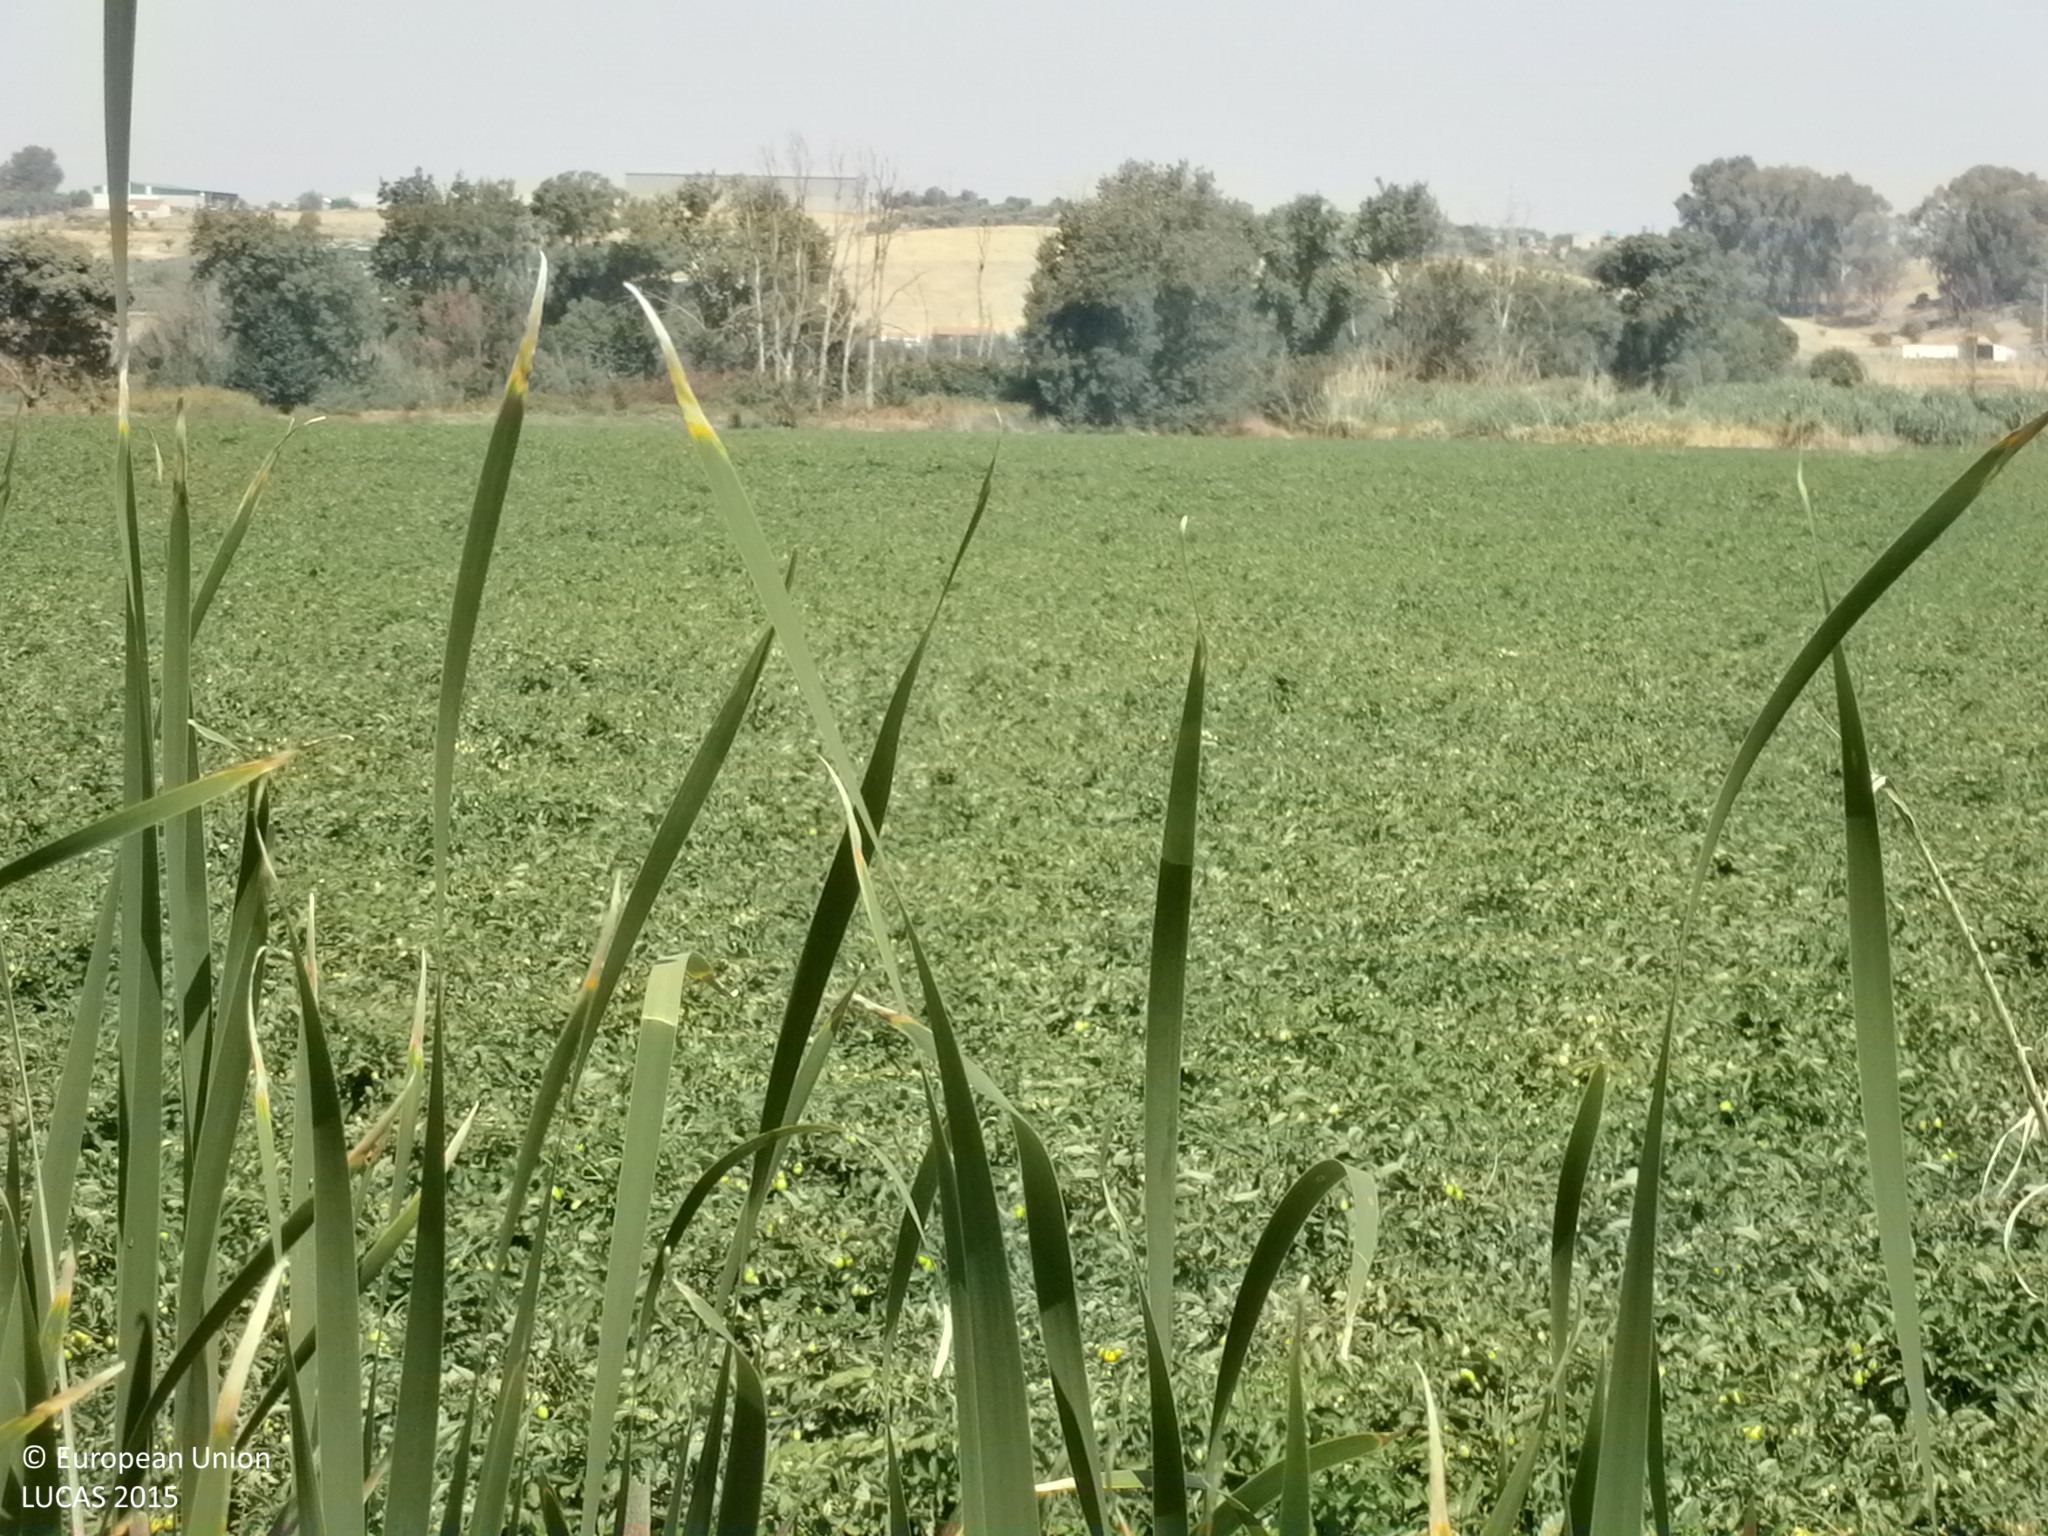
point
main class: Cropland
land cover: Tomatoes
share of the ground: > 75 %
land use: Agriculture (excluding fallow land and kitchen gardens)
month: June
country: ES
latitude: 38.8507
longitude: -6.7610
